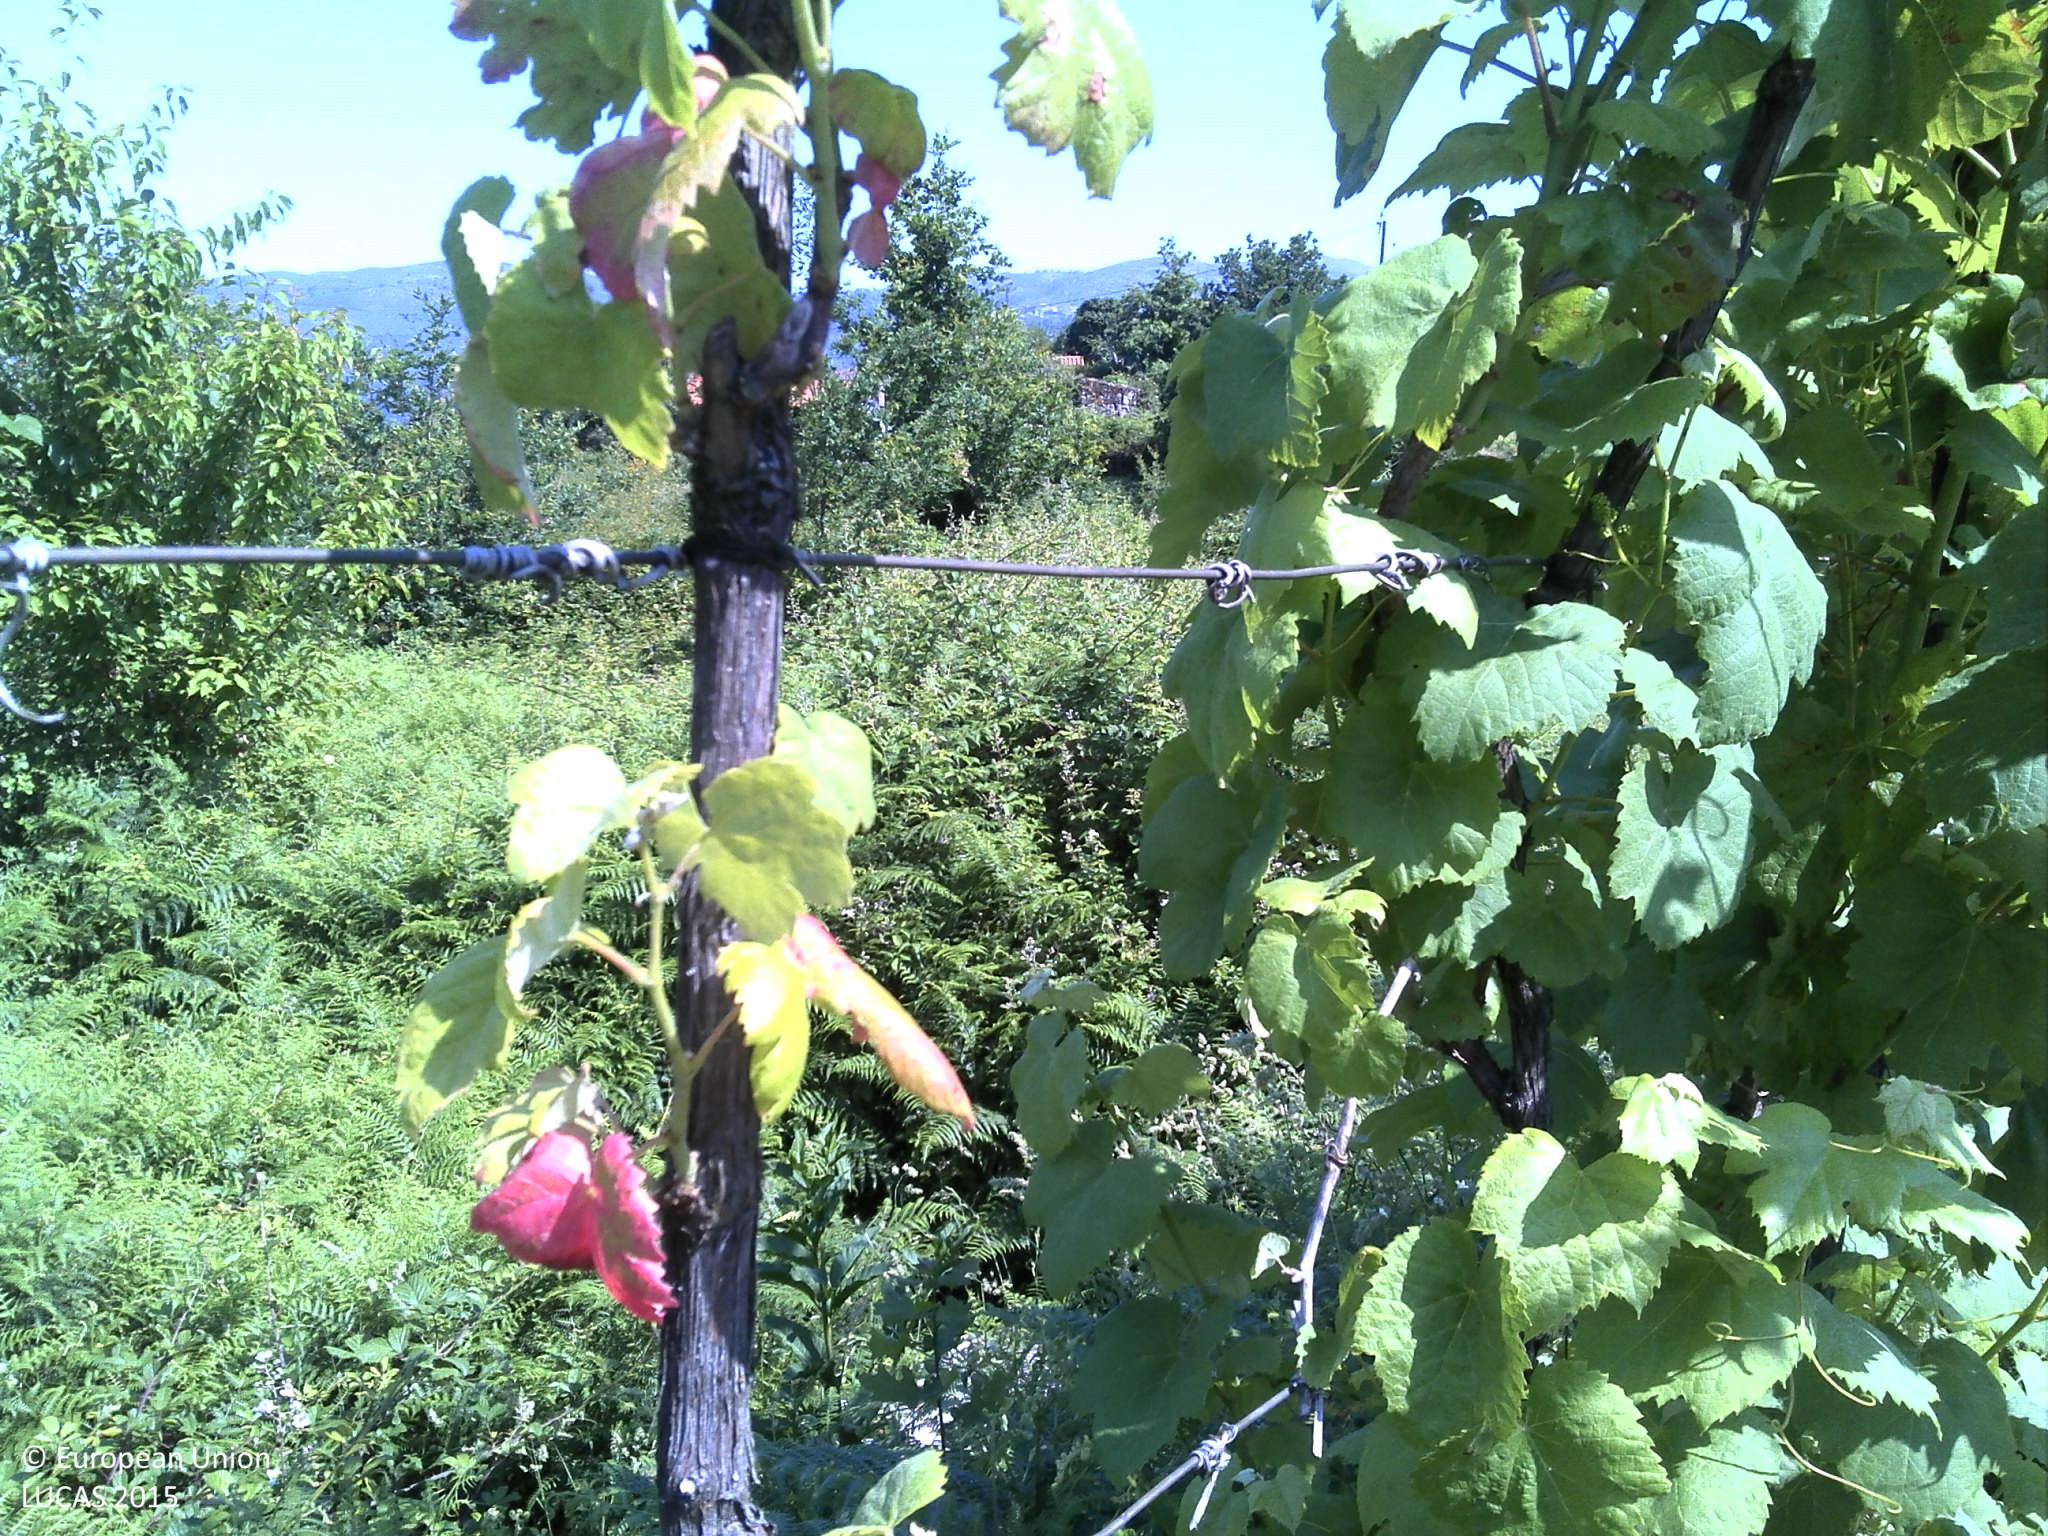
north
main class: Shrubland
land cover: Shrubland with sparse tree cover
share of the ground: > 75 %
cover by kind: shrubs 85 %, herbaceous plants 10 %, broadleaved forest trees 5 %
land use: Abandoned areas
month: June
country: PT
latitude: 41.9249
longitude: -8.4288
